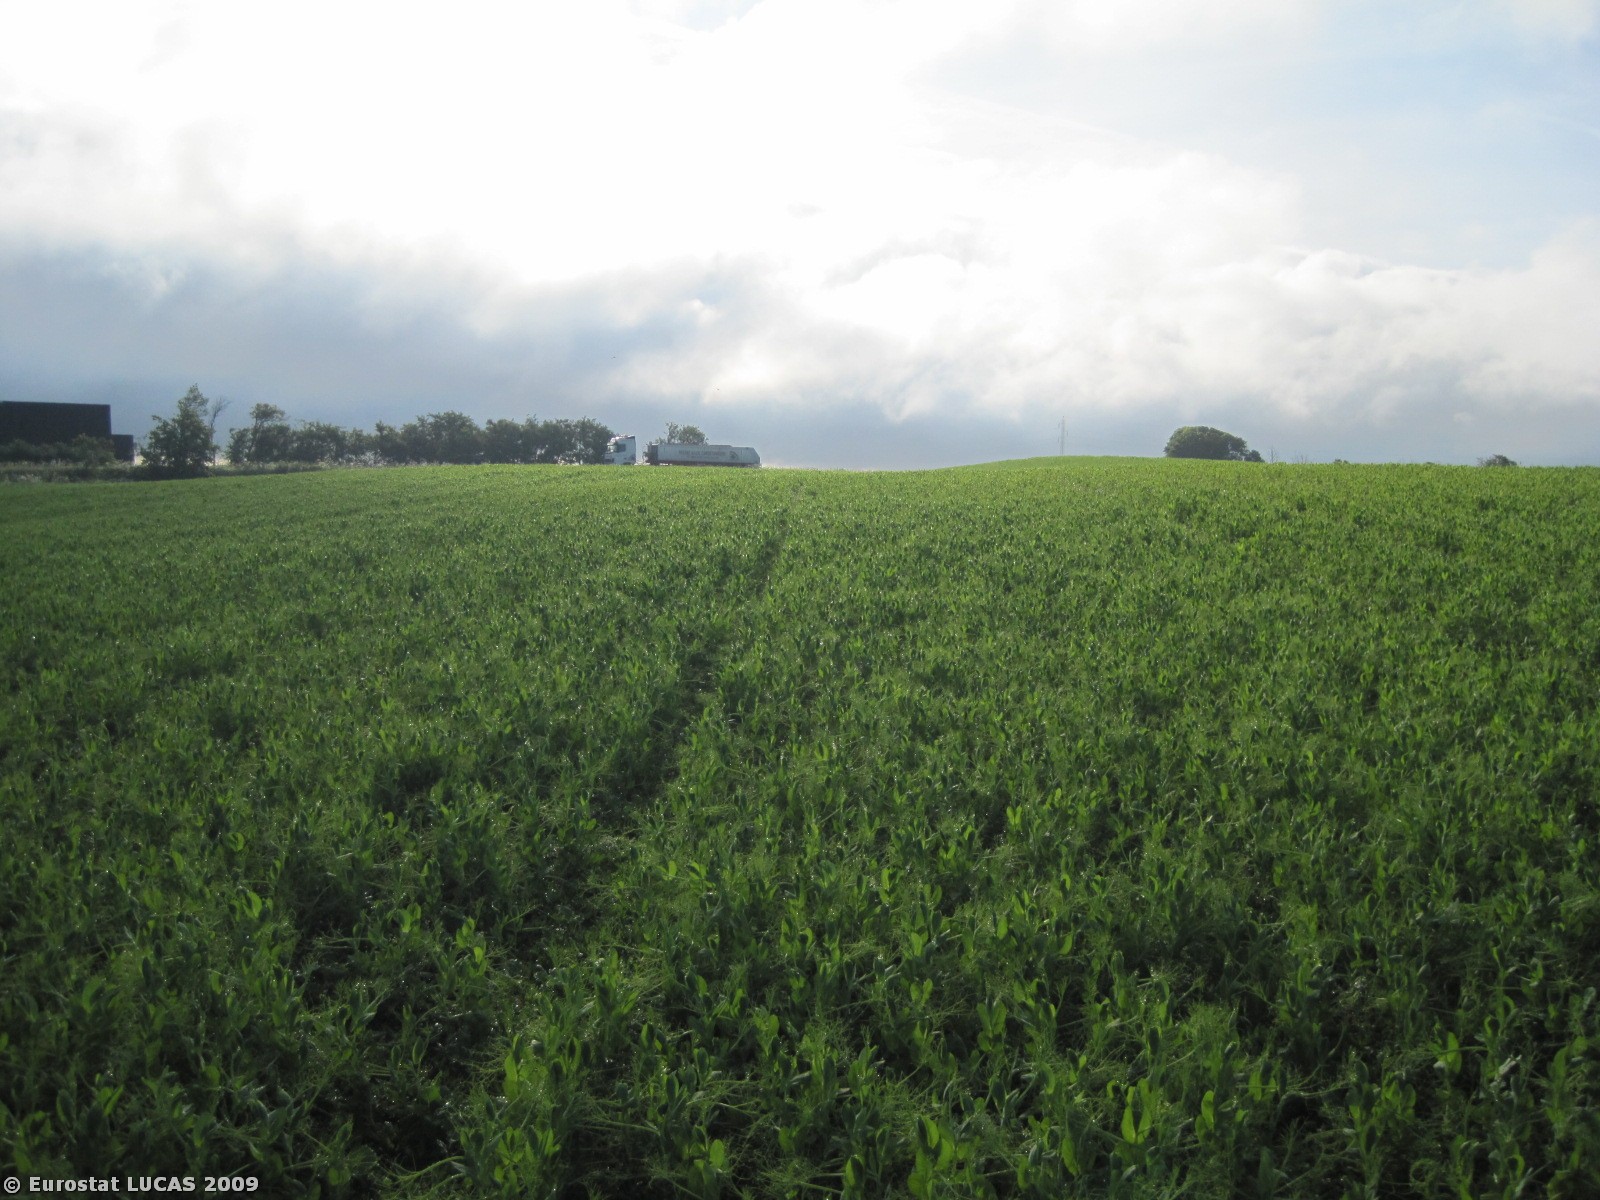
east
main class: Cropland
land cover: Dry pulses
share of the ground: 50 - 75 %
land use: Agriculture (excluding fallow land and kitchen gardens)
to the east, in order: Dry pulses; Grassland without tree/shrub cover; Paved roads, cycling and walking lanes; Grassland without tree/shrub cover; Barley
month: June
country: DK
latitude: 57.3382
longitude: 10.1493
